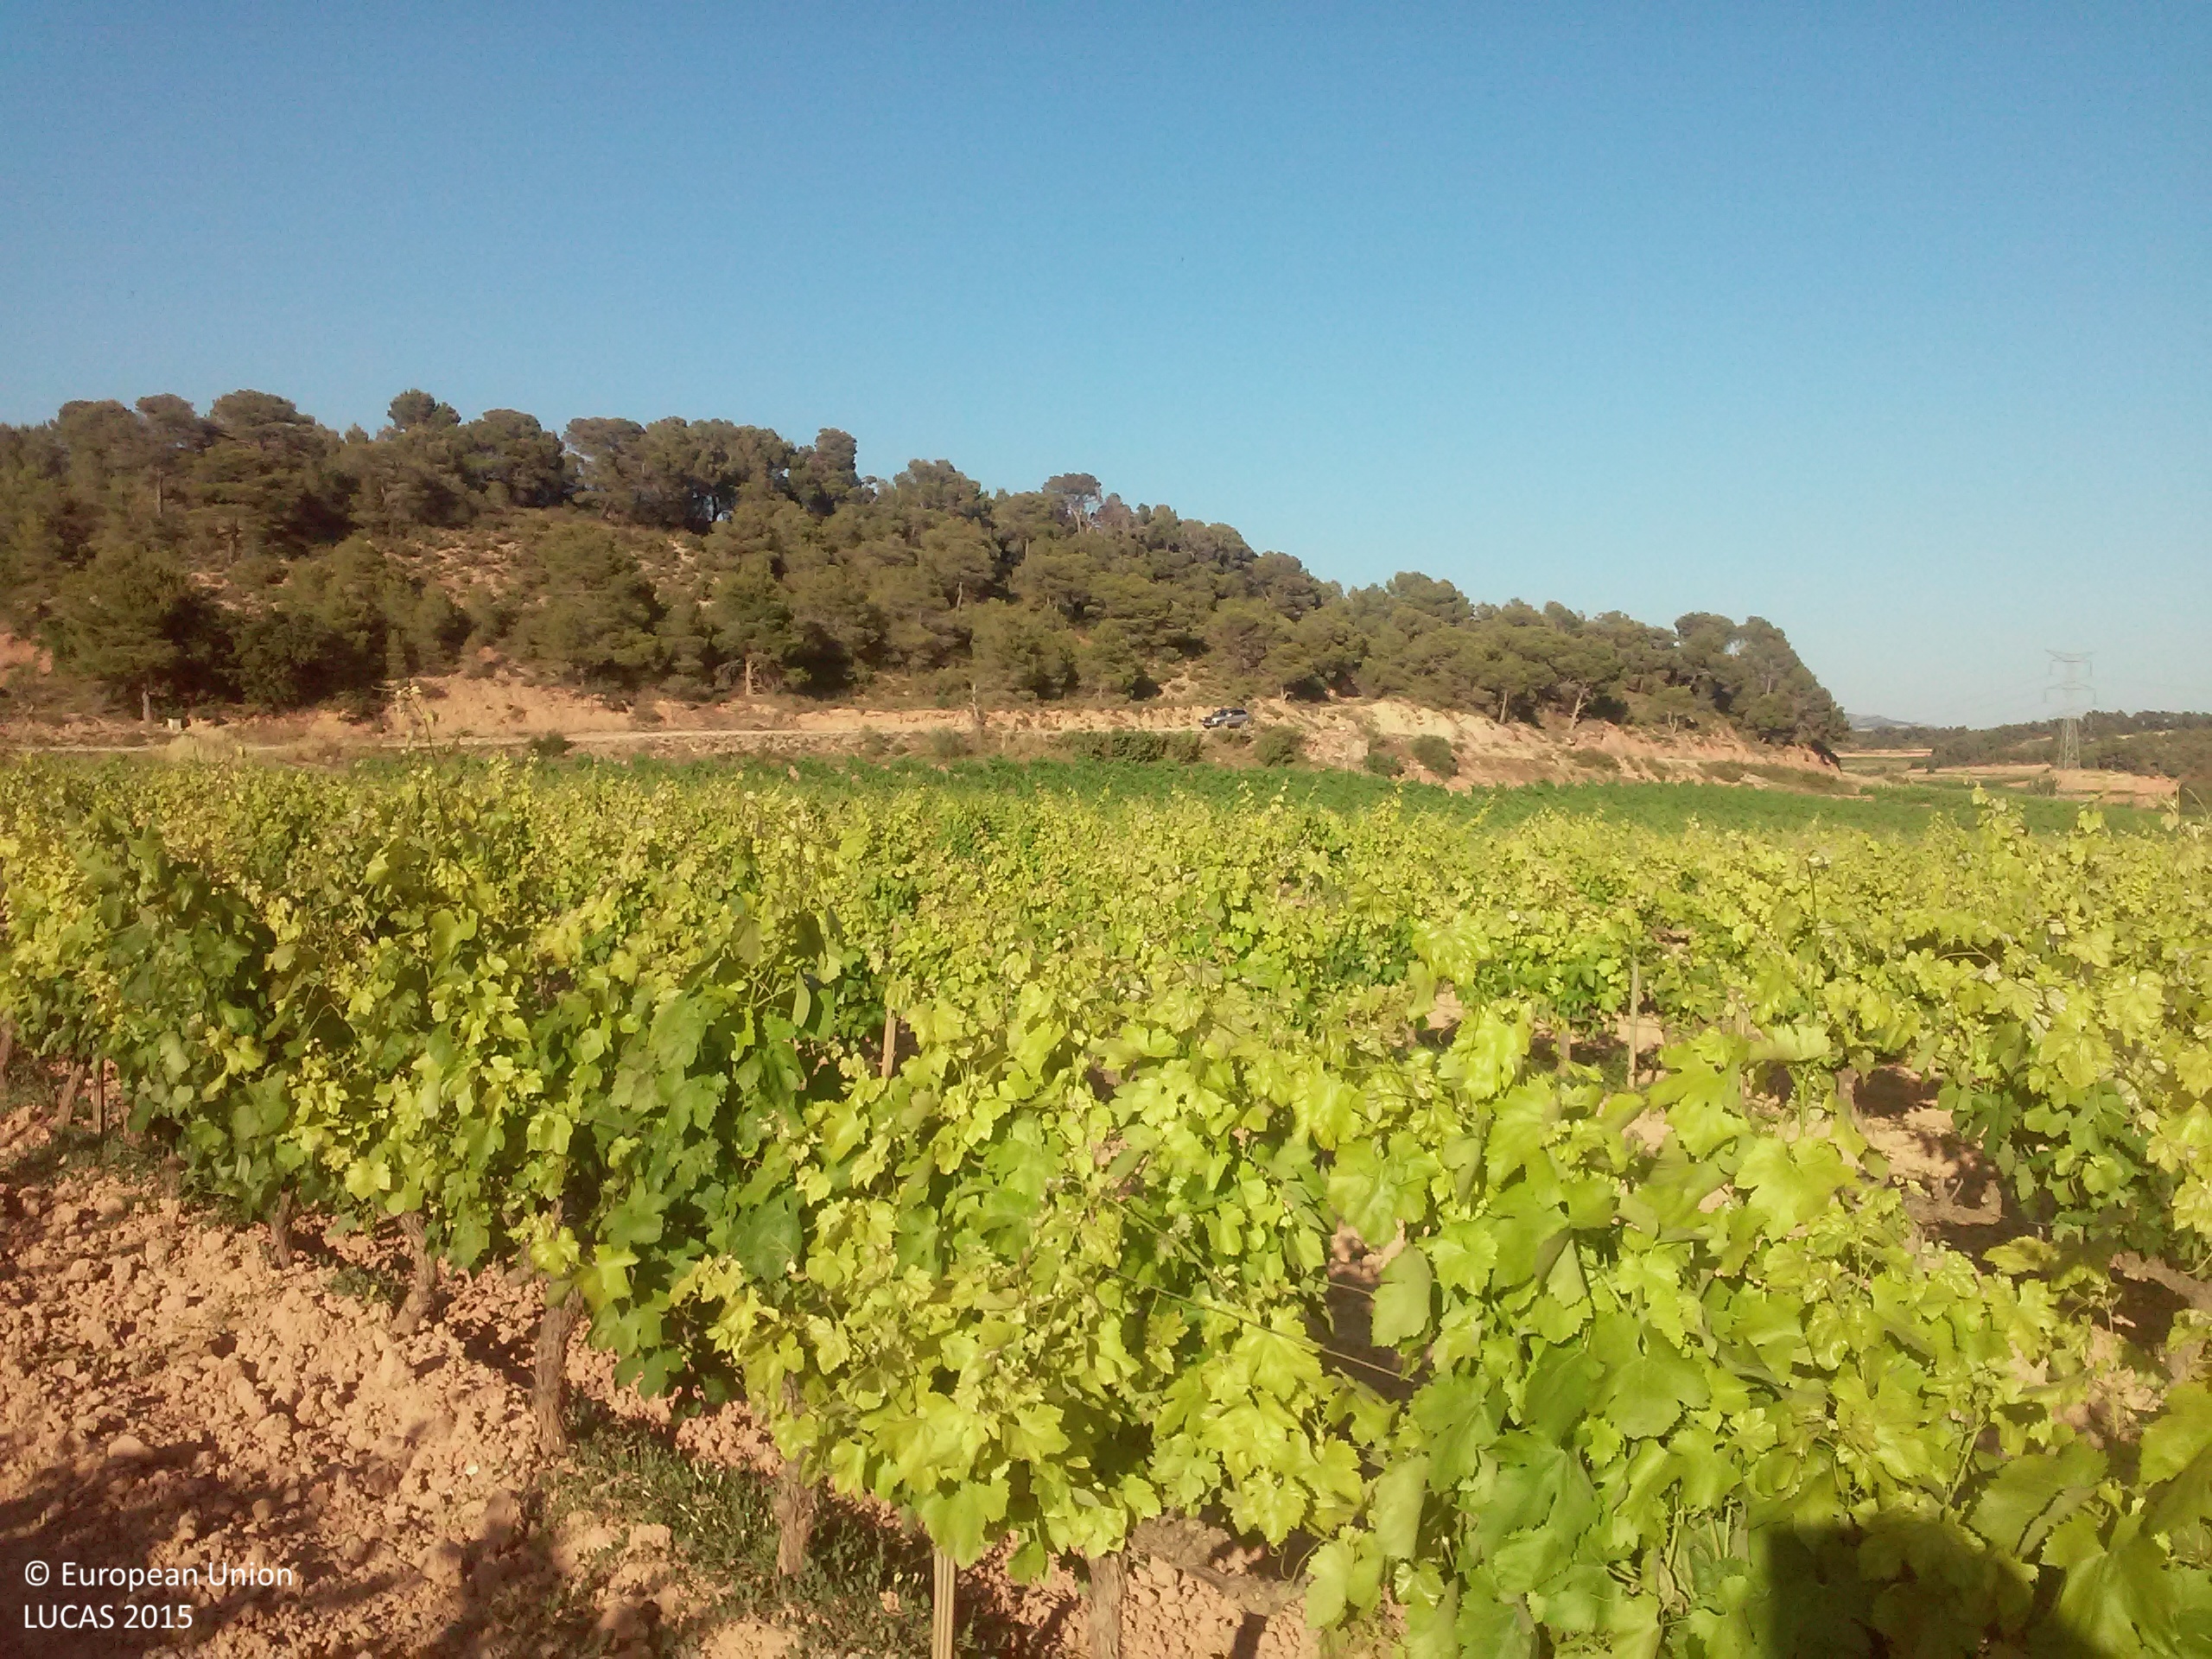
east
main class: Cropland
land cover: Vineyards
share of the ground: 10 - 25 %
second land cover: Other bare soil
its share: > 75 %
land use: Agriculture (excluding fallow land and kitchen gardens)
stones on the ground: 10 - 25 %
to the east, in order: Vineyards; Other bare soil; Shruby margins; Vineyards; Shruby margins; Tracks; Pine dominated coniferous woodland
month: June
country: ES
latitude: 41.4524
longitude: 1.1927
